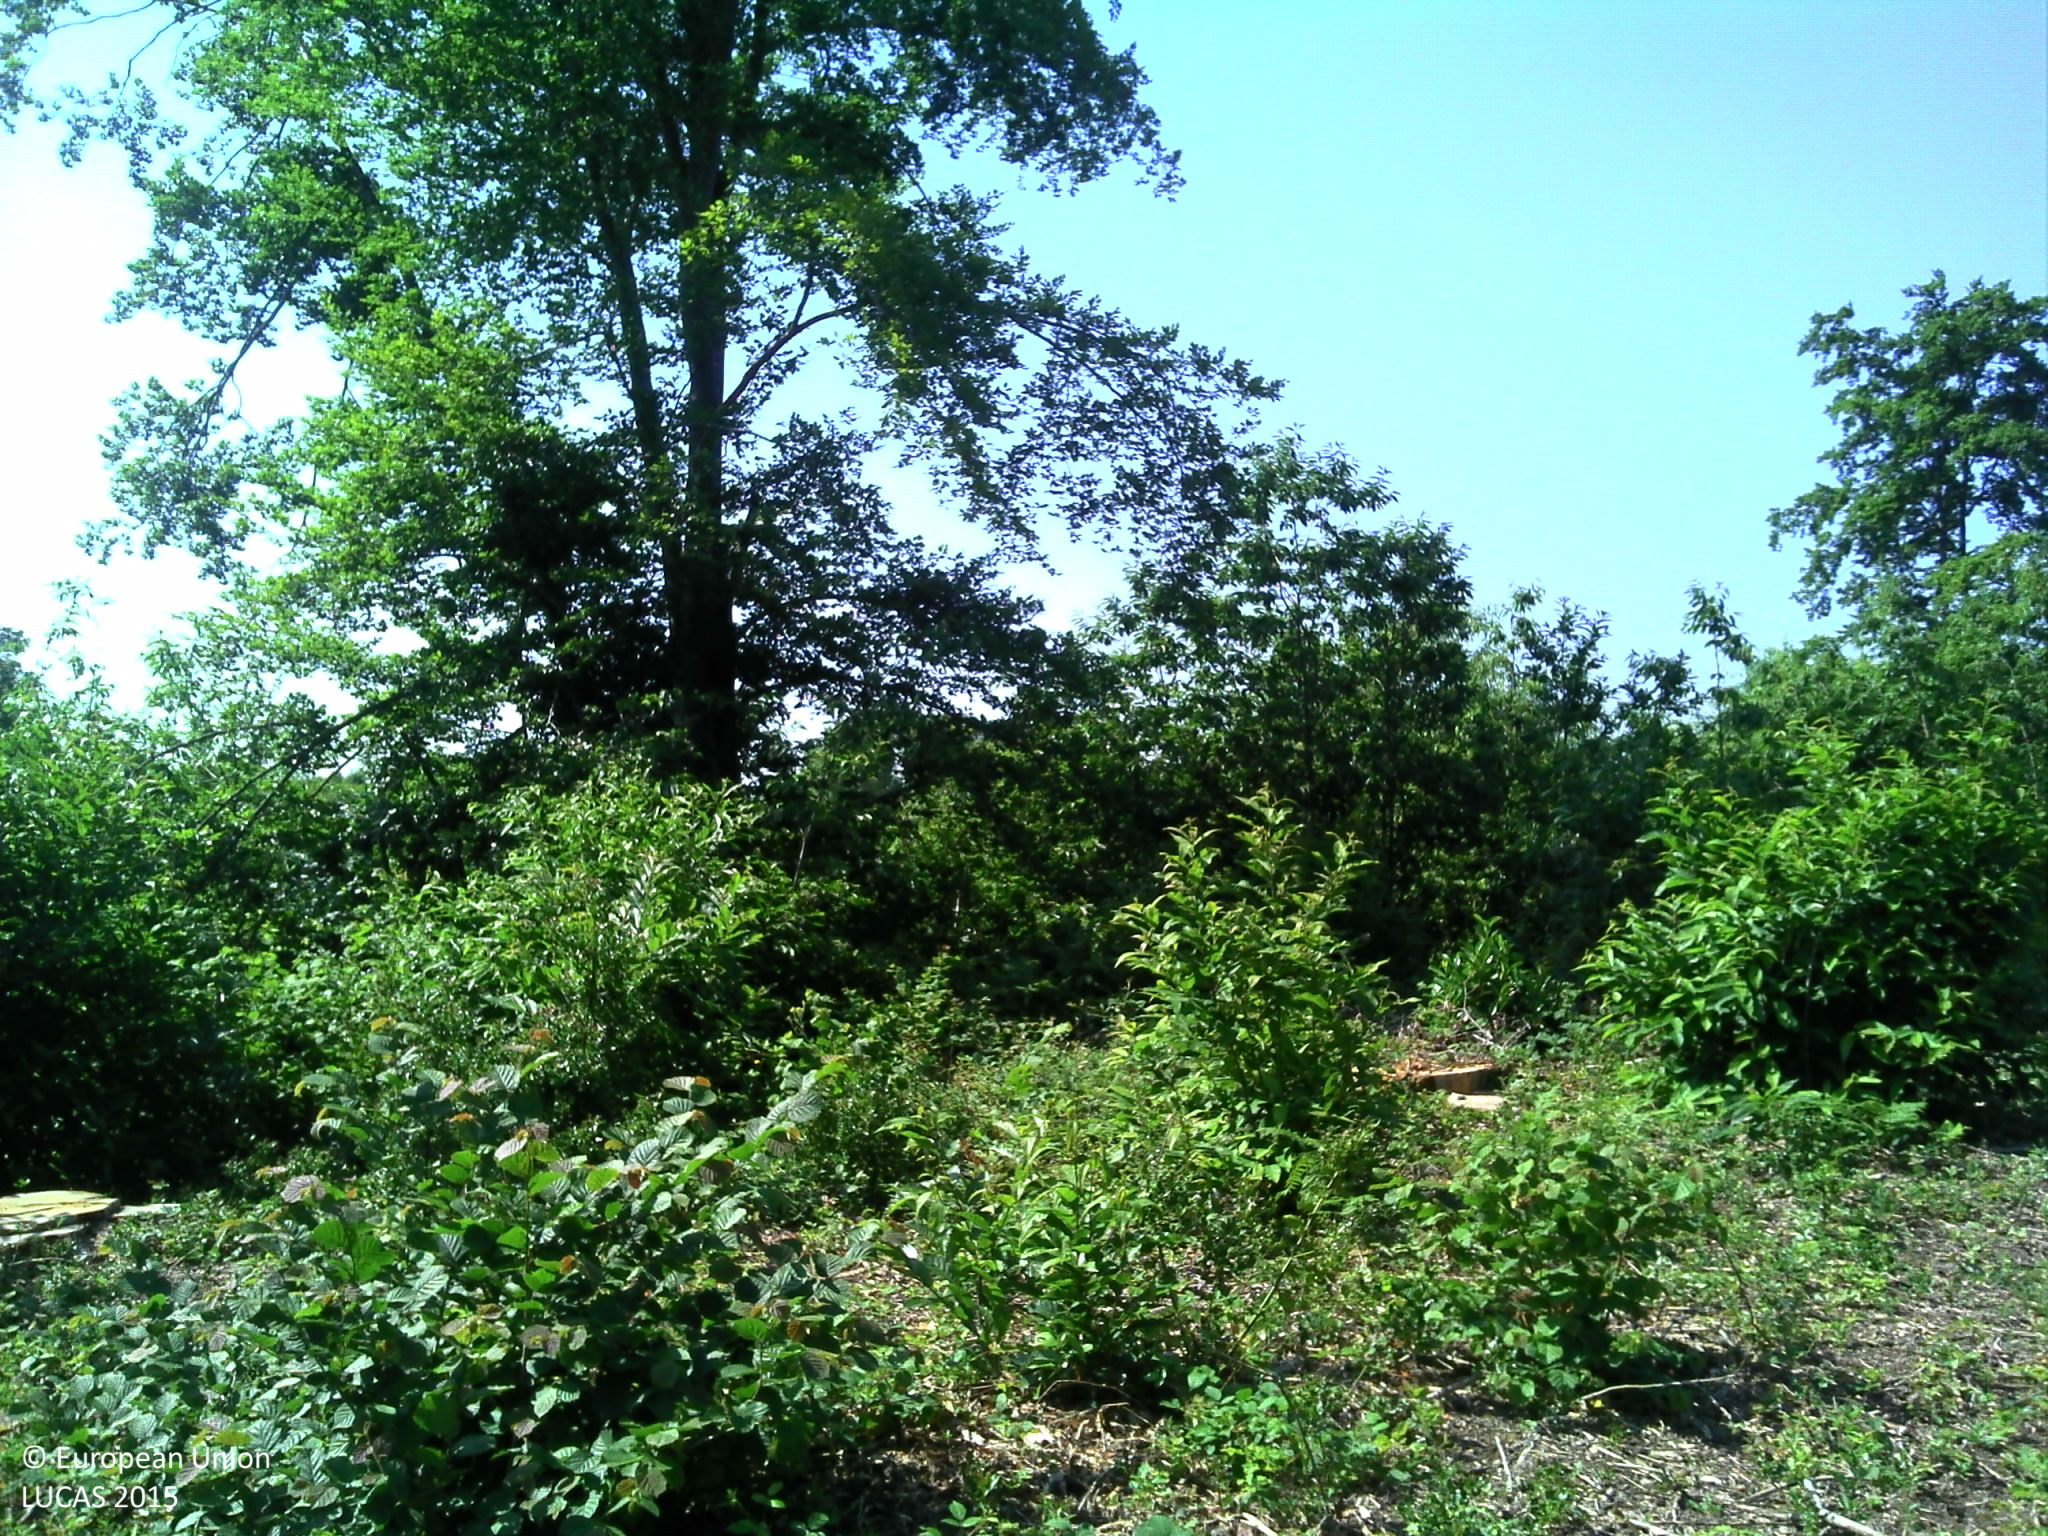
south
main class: Grassland
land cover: Grassland with sparse tree/shrub cover
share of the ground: 50 - 75 %
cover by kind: herbaceous plants 85 %, shrubs 10 %, broadleaved forest trees 5 %
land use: Forestry
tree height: < 5 m
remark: Clear cut
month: June
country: FR
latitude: 47.7553
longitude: 0.0621
